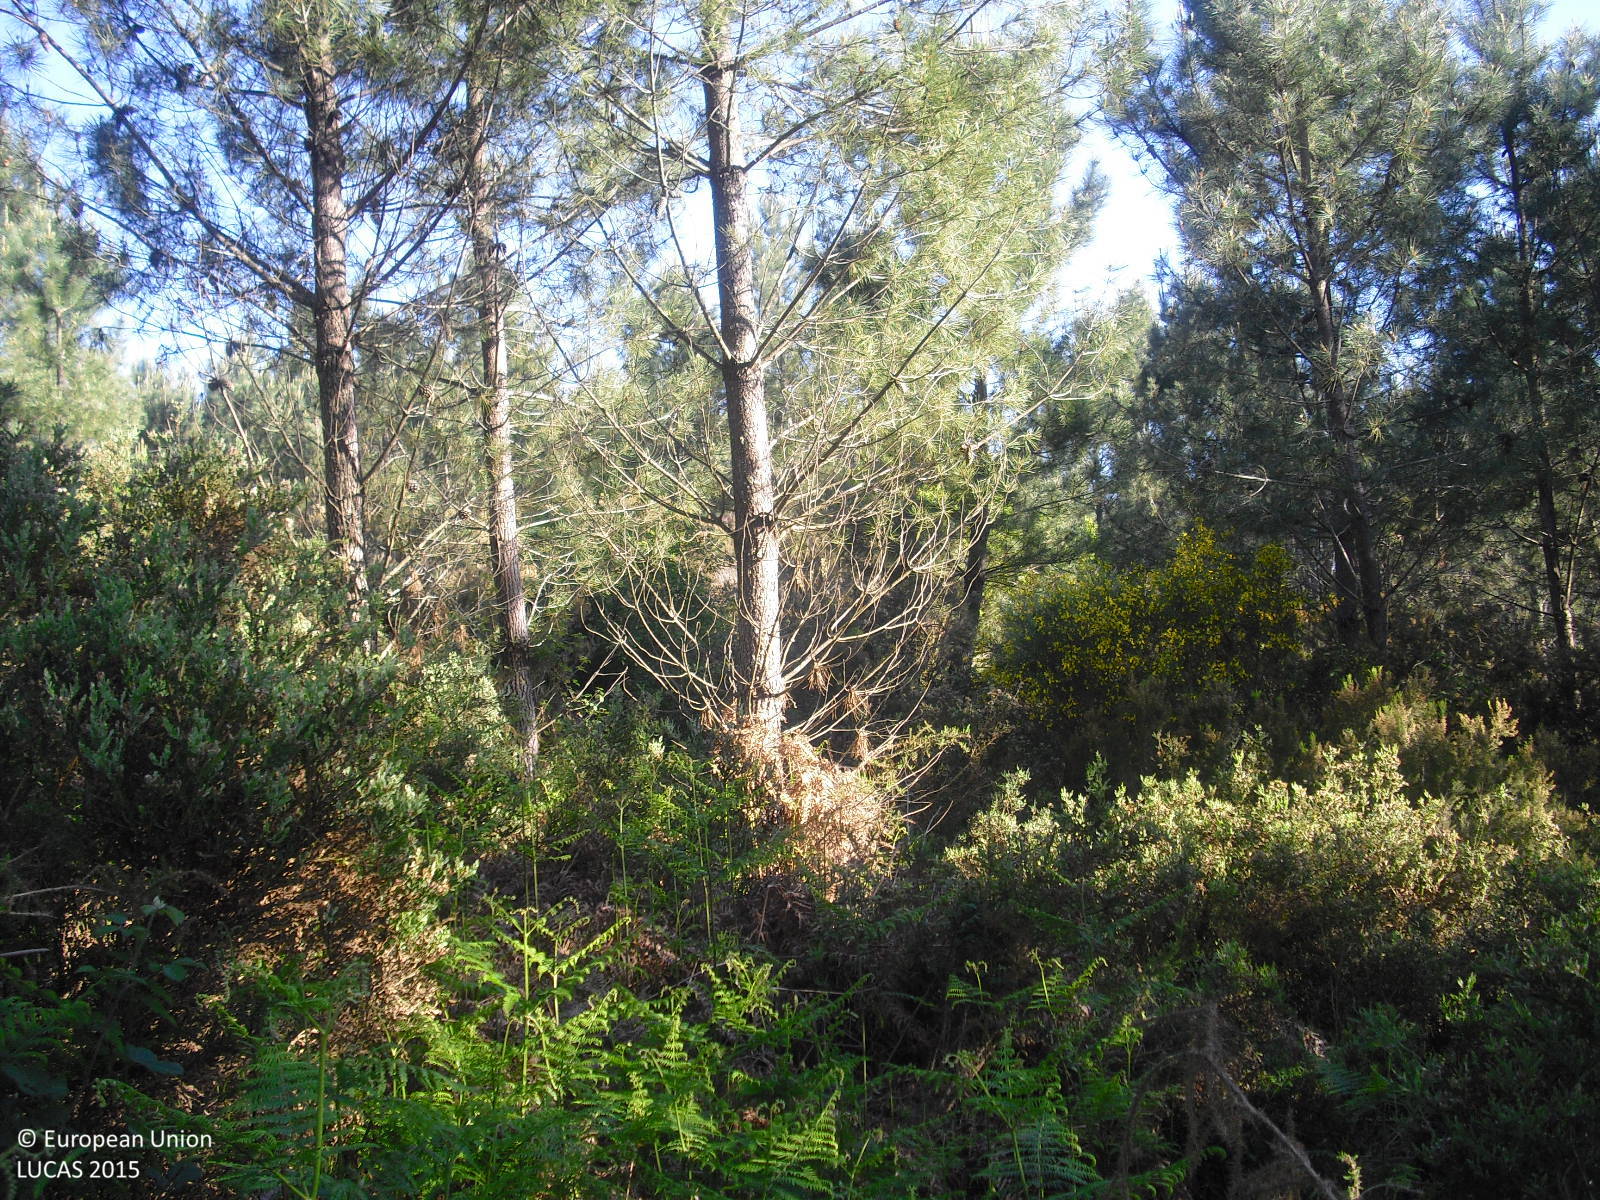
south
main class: Woodland
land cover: Pine dominated coniferous woodland
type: hemiboreal forest and nemoral coniferous forest and mixed broadleaved-coniferous forest
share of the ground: 25 - 50 %
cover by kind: coniferous forest trees 50 %, shrubs 50 %
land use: Forestry
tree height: > 5 m
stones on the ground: 25 - 50 %
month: May
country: ES
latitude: 41.8942
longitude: -8.1958
